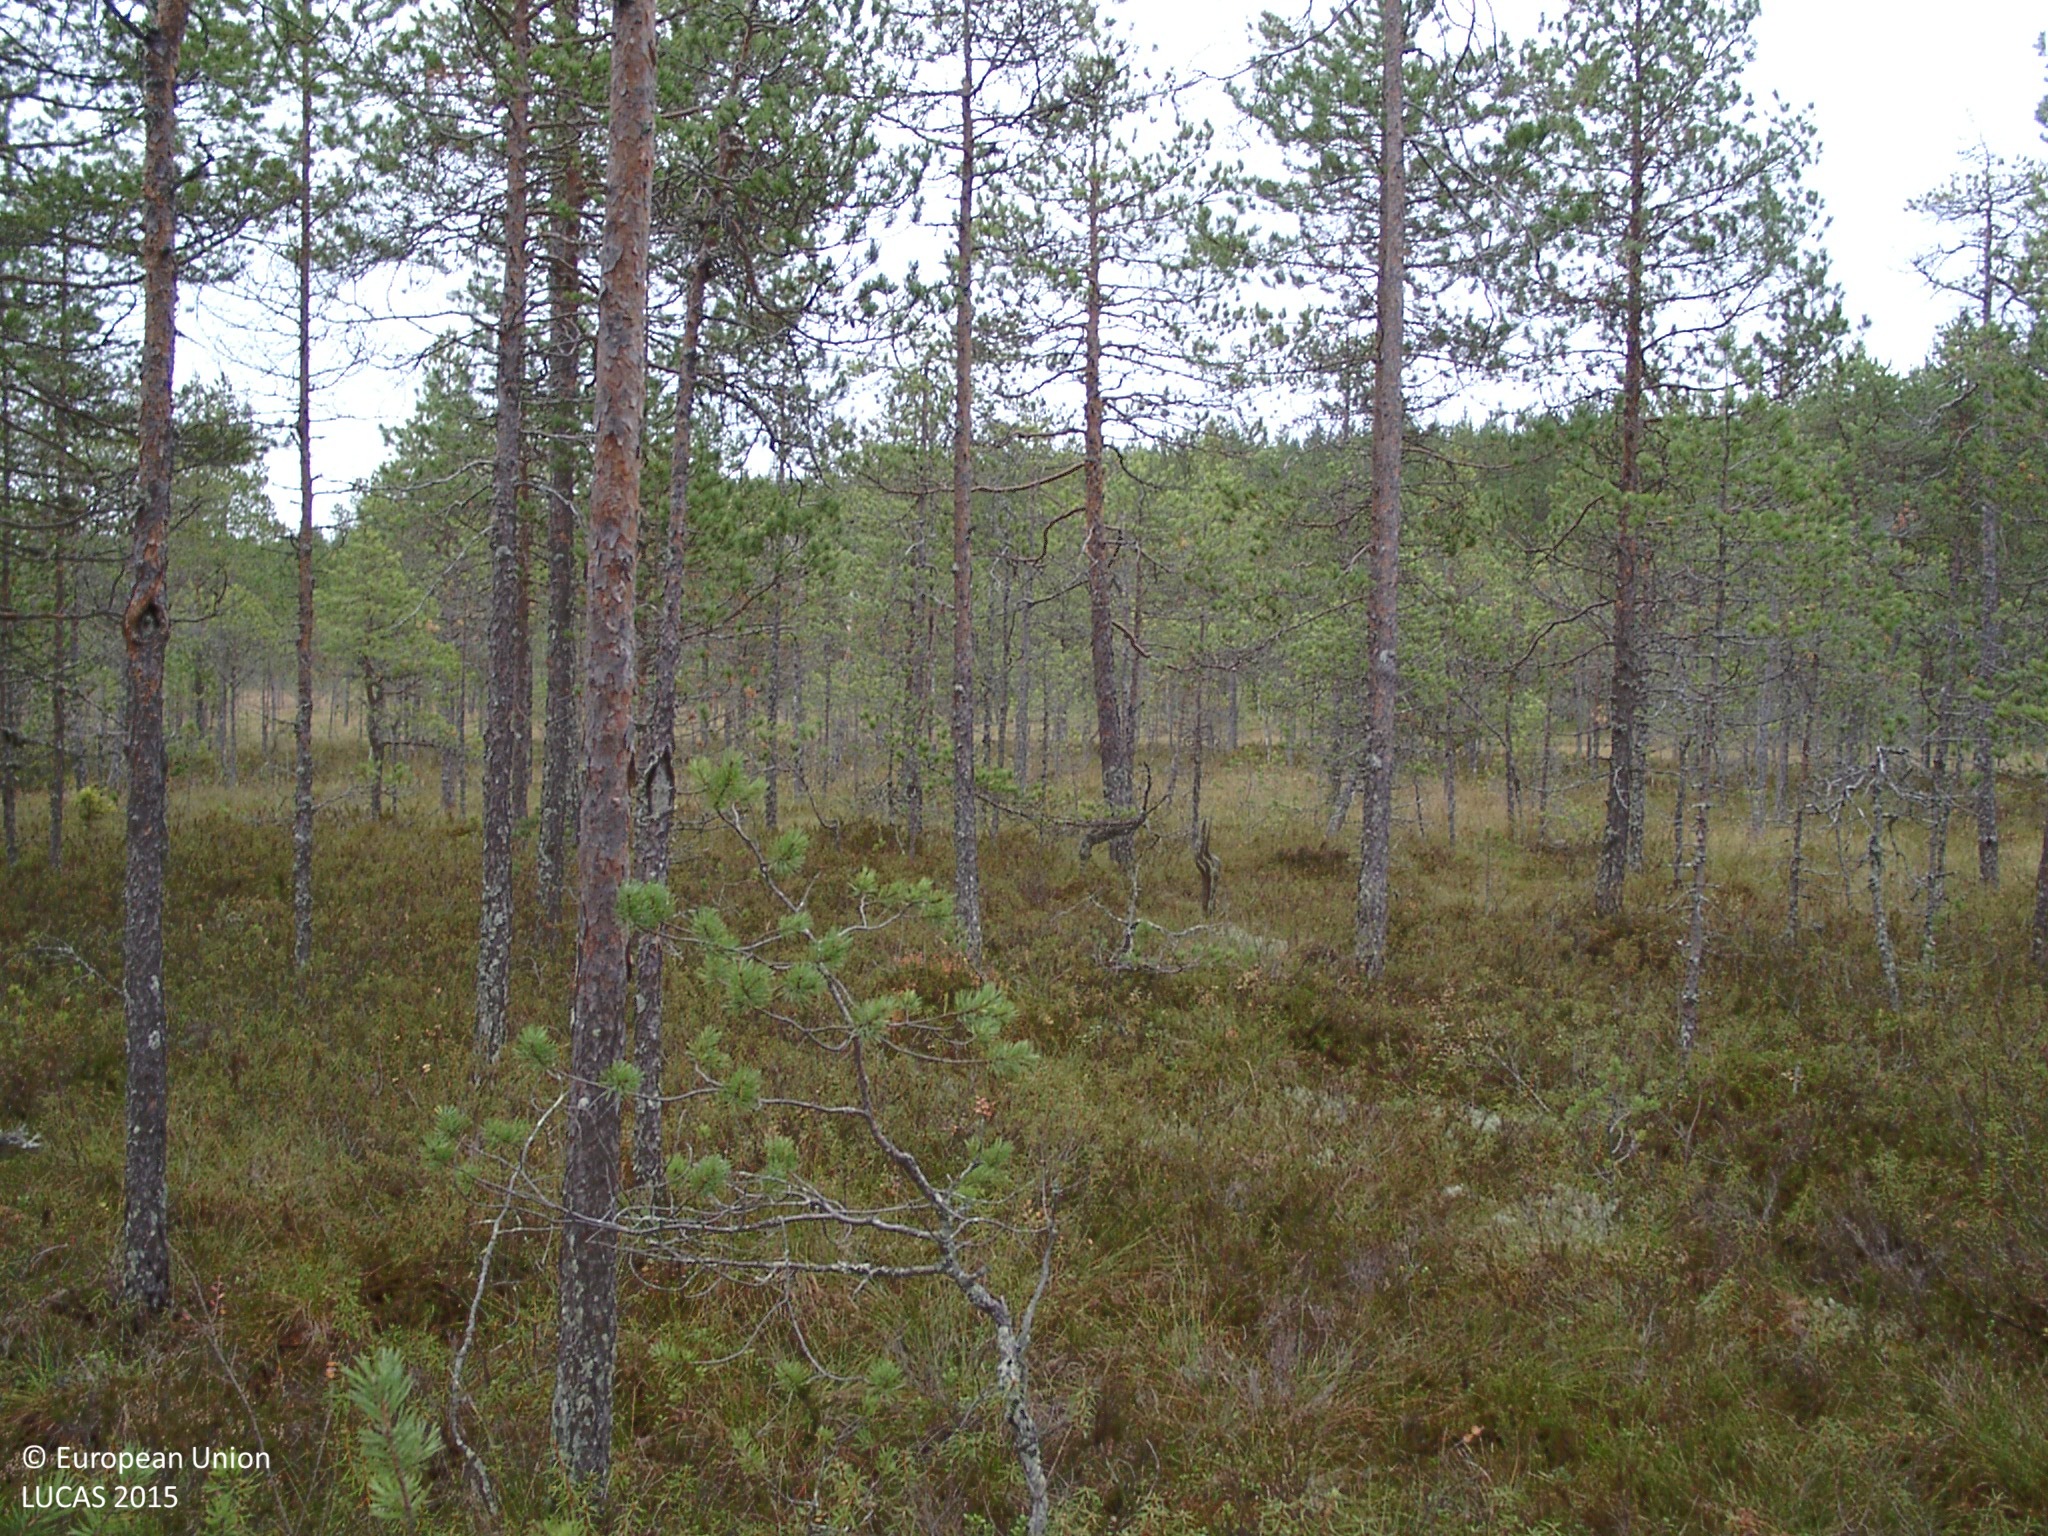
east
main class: Woodland
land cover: Pine dominated coniferous woodland
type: mire and swamp forests
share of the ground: 10 - 25 %
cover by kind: shrubs 60 %, coniferous forest trees 20 %, lichens and mosses 15 %, herbaceous plants 5 %
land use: Amenities, museums, leisure
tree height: < 5 m
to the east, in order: Pine dominated coniferous woodland; Peatbogs; Pine dominated coniferous woodland
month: September
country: FI
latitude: 62.8414
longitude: 25.4437
